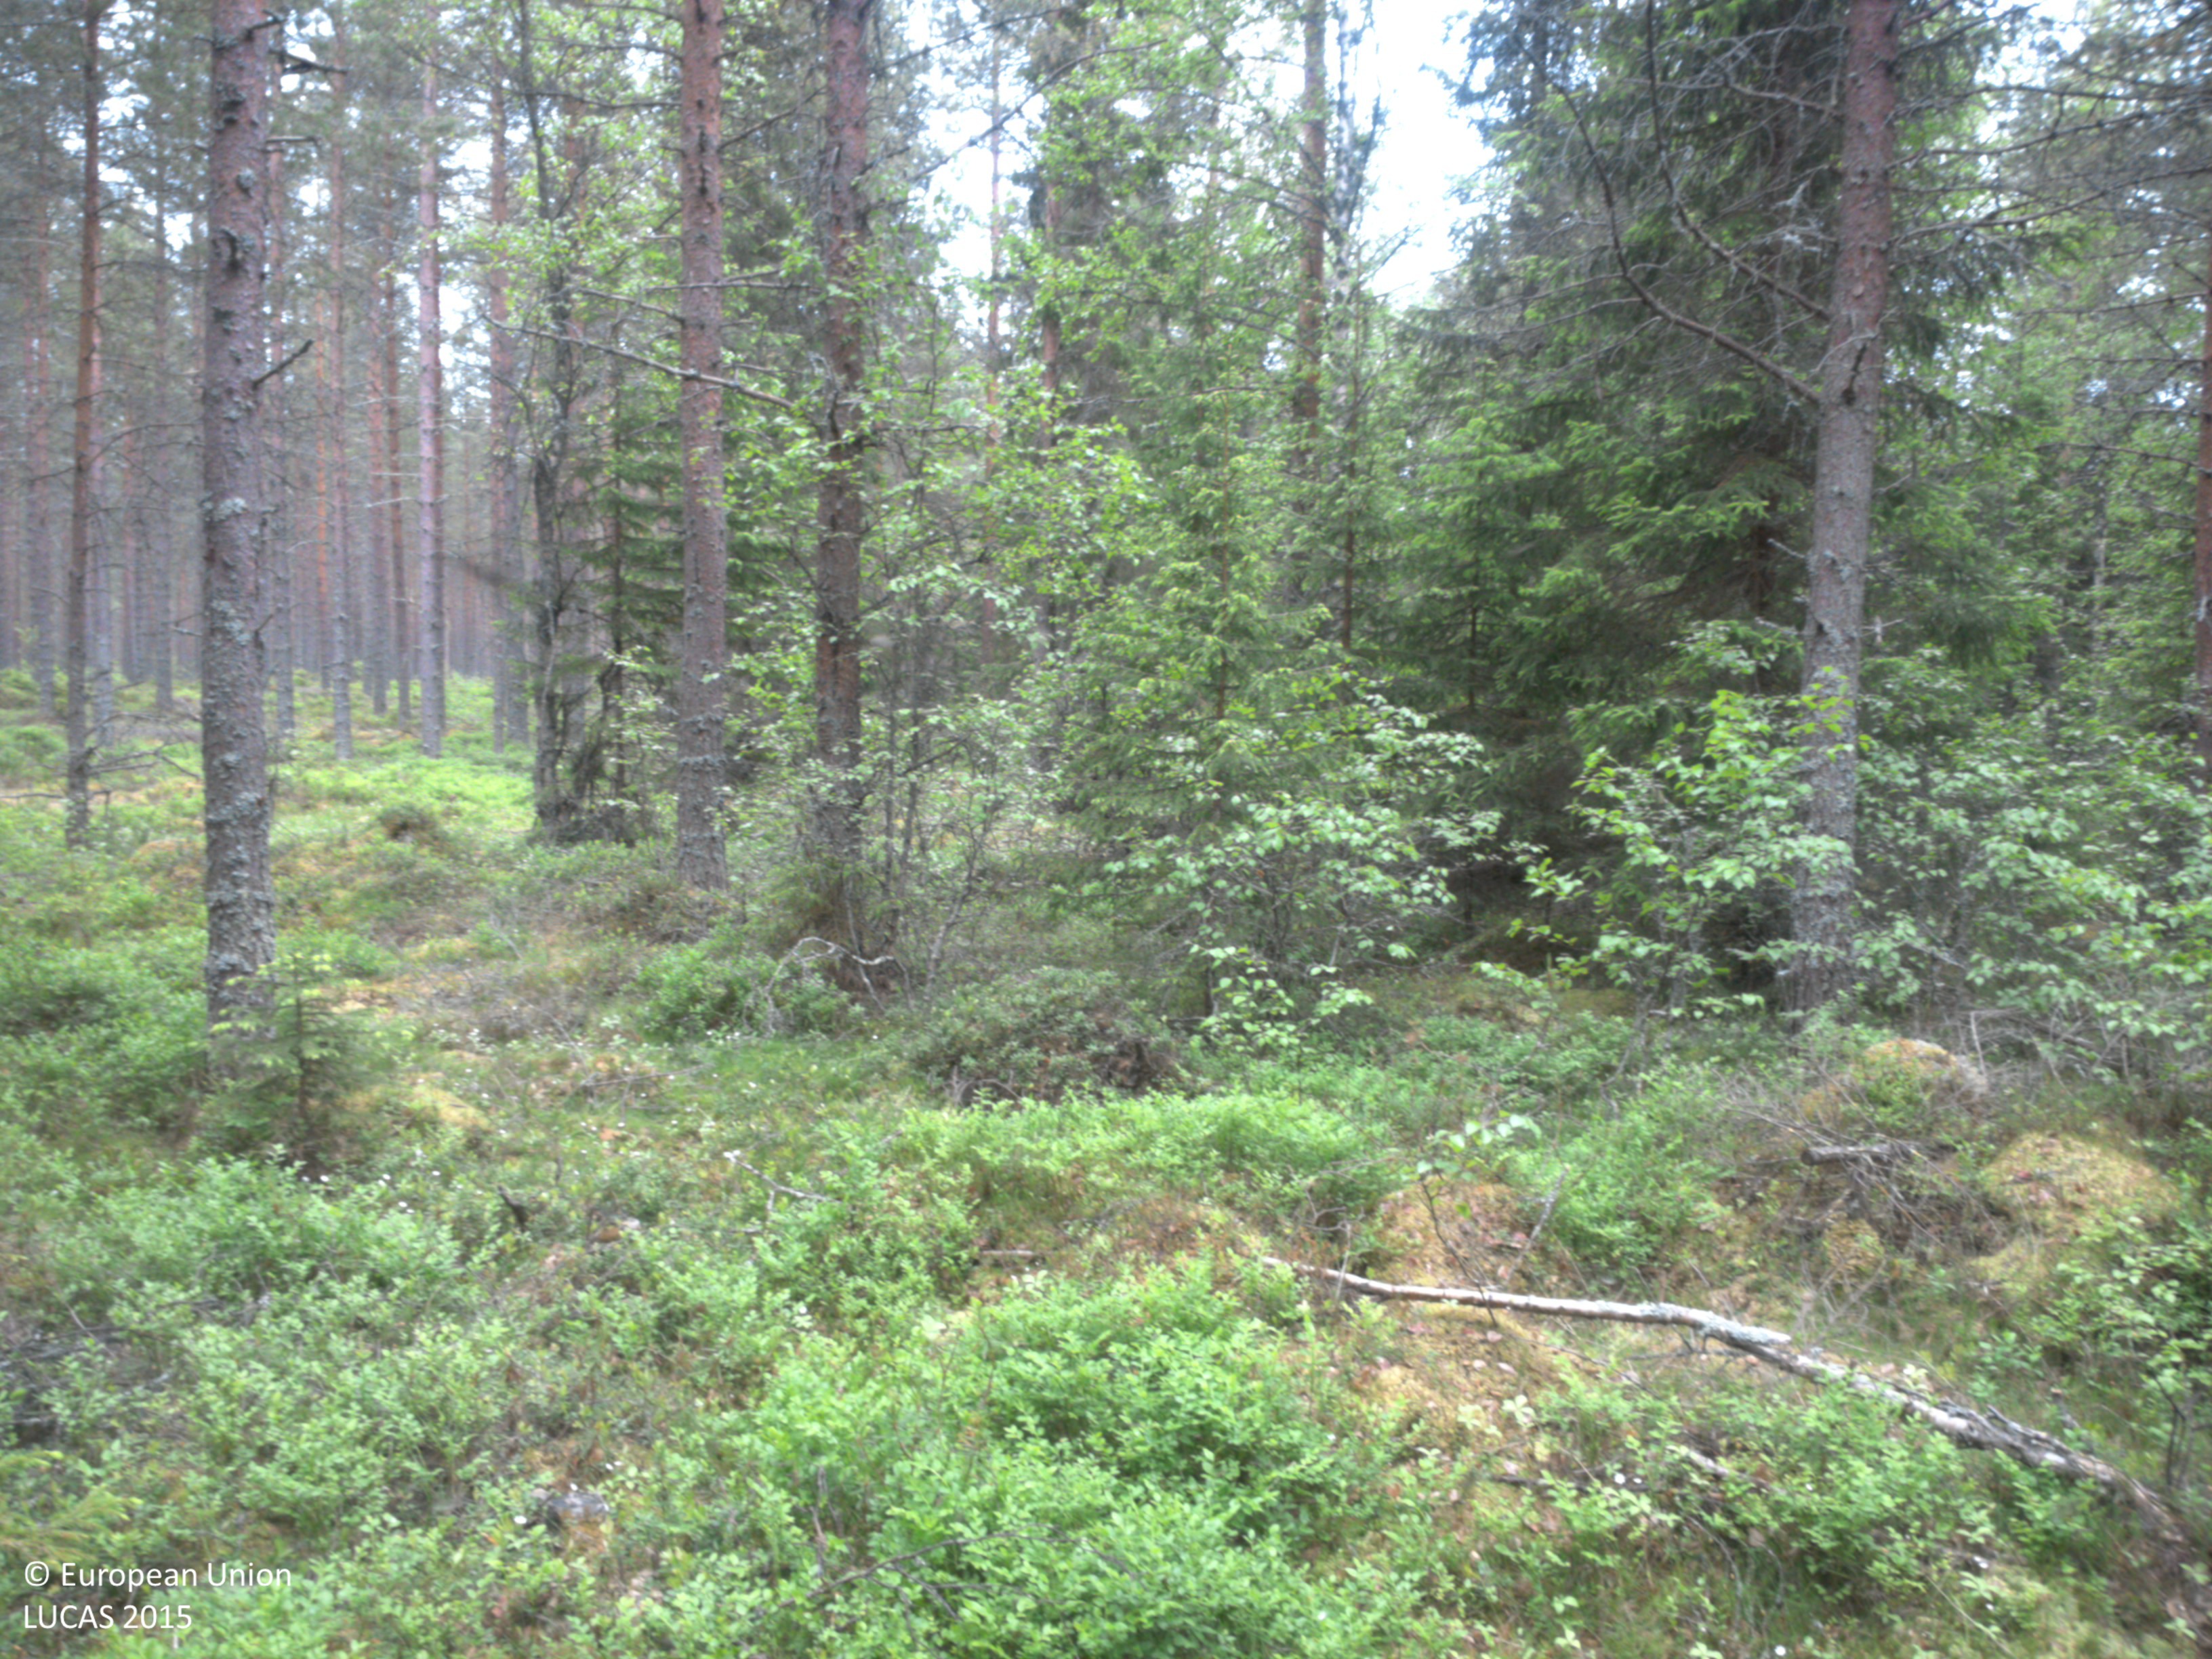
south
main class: Woodland
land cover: Other mixed woodland
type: boreal forest
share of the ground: 50 - 75 %
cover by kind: coniferous forest trees 40 %, broadleaved forest trees 25 %, lichens and mosses 20 %, shrubs 15 %
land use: Forestry
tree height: > 5 m
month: June
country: SE
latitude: 63.6283
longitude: 19.9699
